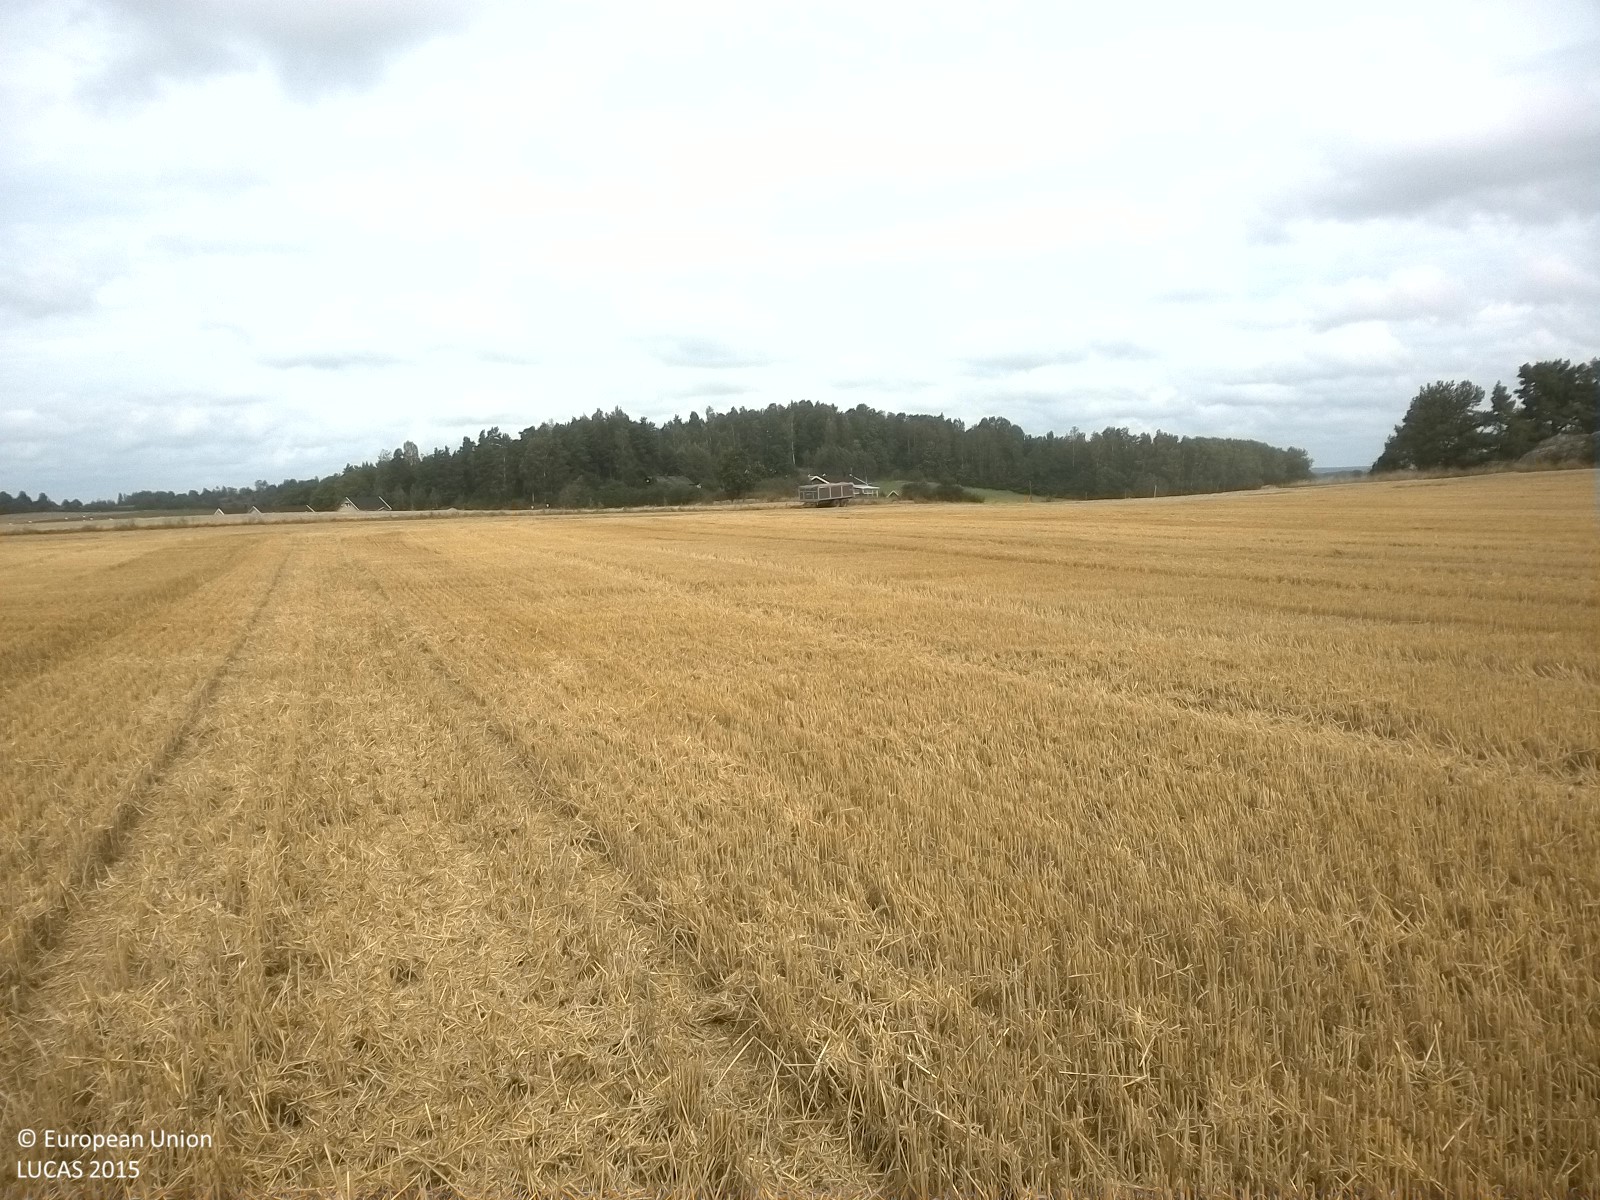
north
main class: Cropland
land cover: Common wheat
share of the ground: > 75 %
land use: Agriculture (excluding fallow land and kitchen gardens)
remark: Harvested field
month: September
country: SE
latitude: 58.5721
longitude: 16.4092
